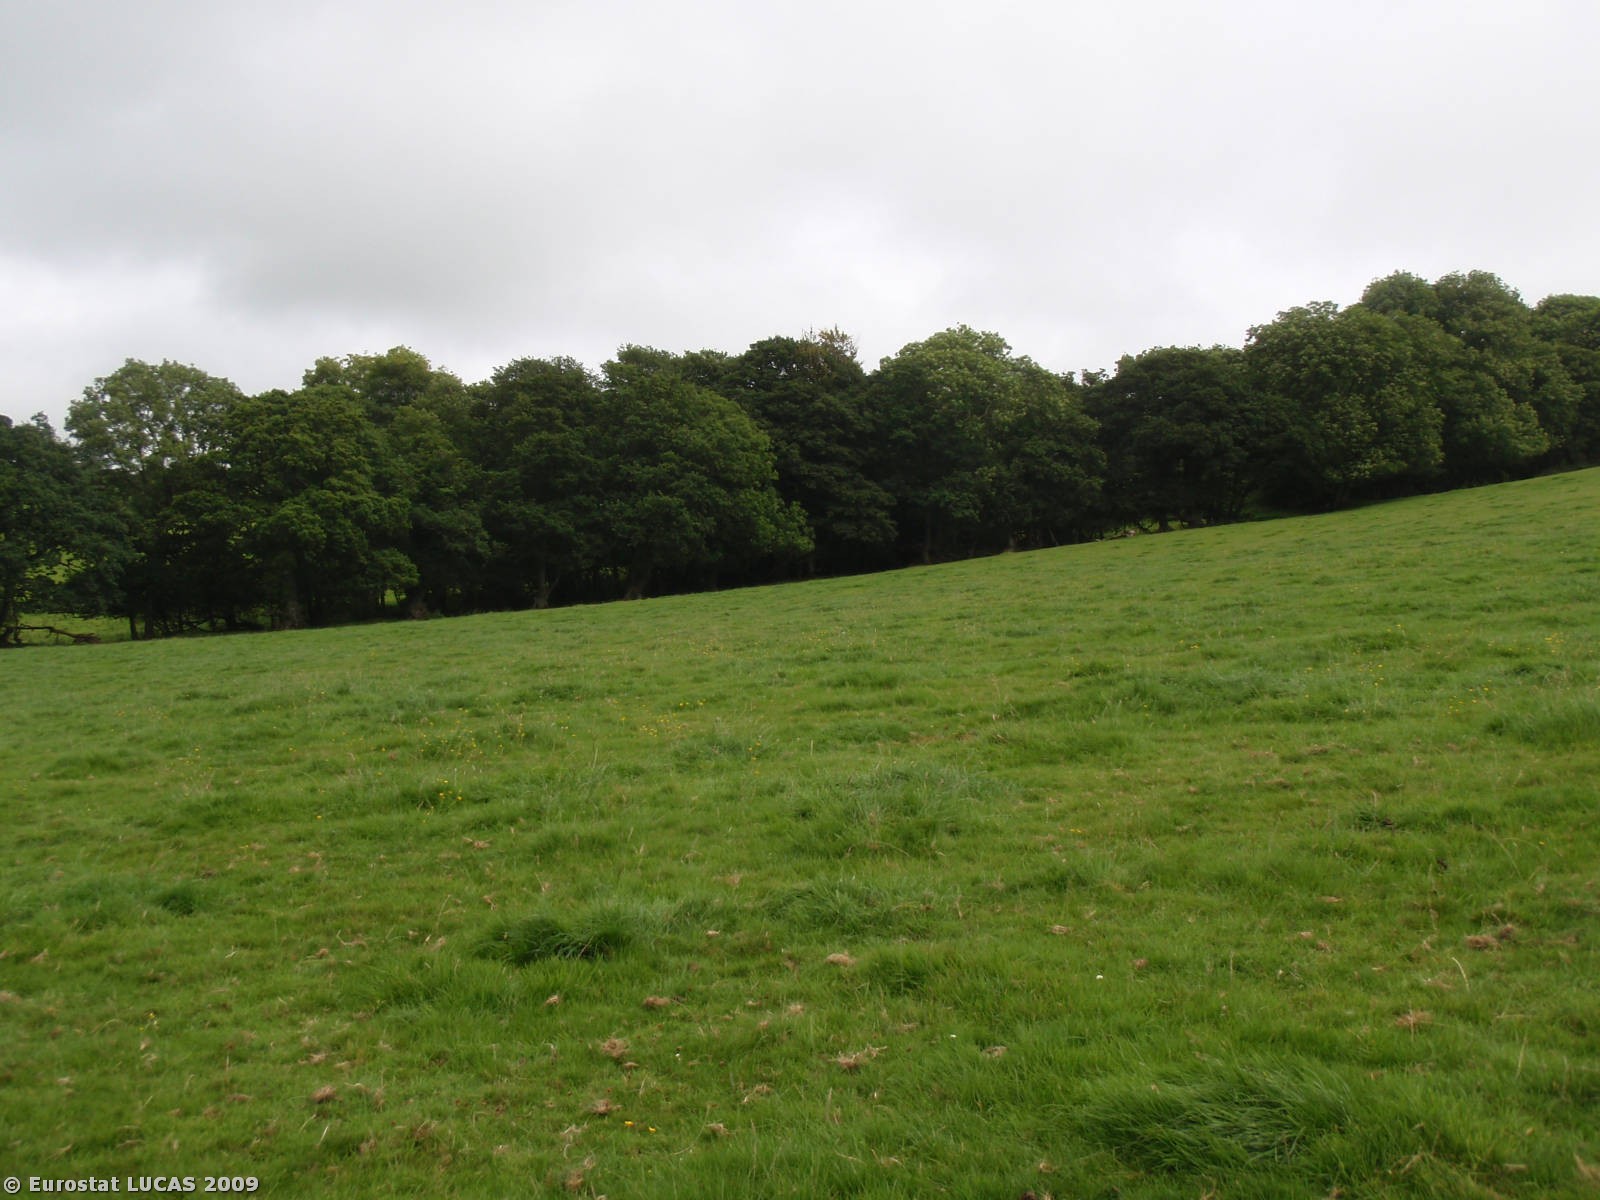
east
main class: Grassland
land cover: Grassland without tree/shrub cover
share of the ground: > 75 %
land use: Agriculture (excluding fallow land and kitchen gardens)
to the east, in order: Grassland without tree/shrub cover; Broadleaved woodland; Rivers and streams; Broadleaved woodland; Grassland without tree/shrub cover
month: August
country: GB
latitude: 50.6101
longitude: -4.3022
